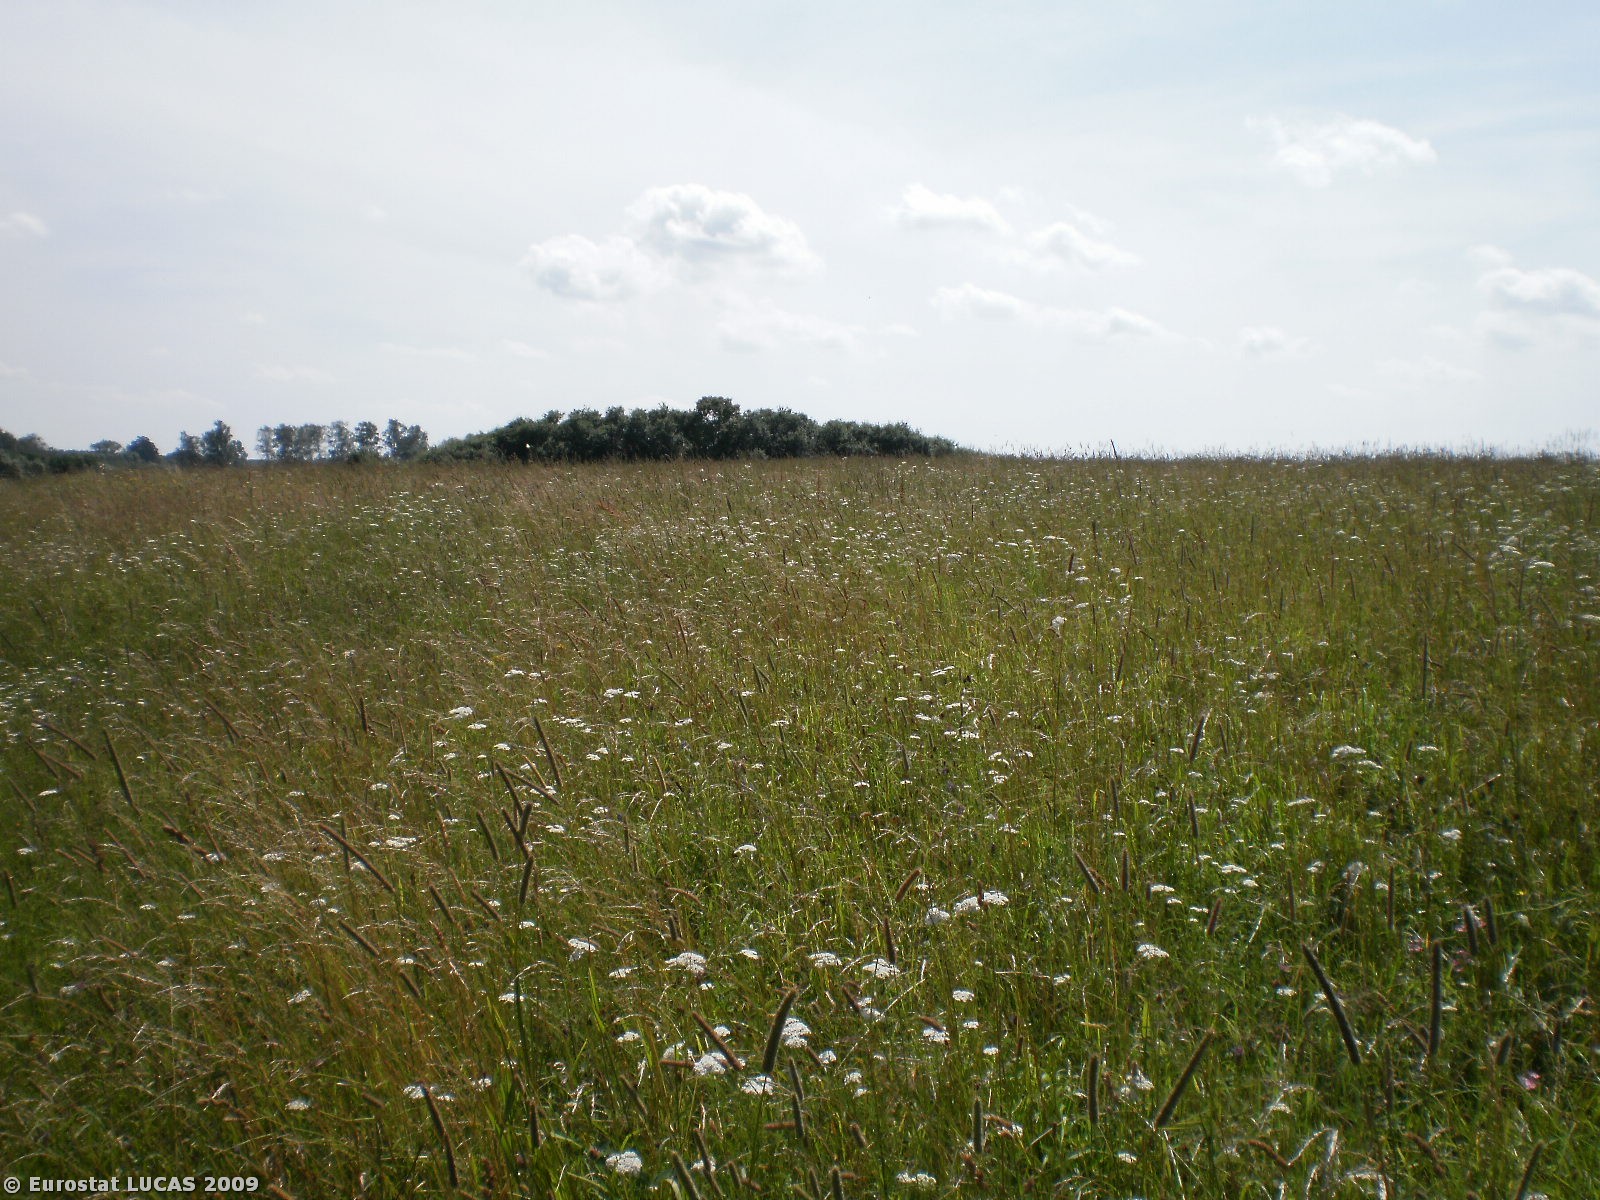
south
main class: Grassland
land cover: Grassland without tree/shrub cover
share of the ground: > 75 %
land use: Agriculture (excluding fallow land and kitchen gardens)
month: July
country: PL
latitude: 54.1317
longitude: 19.9627
